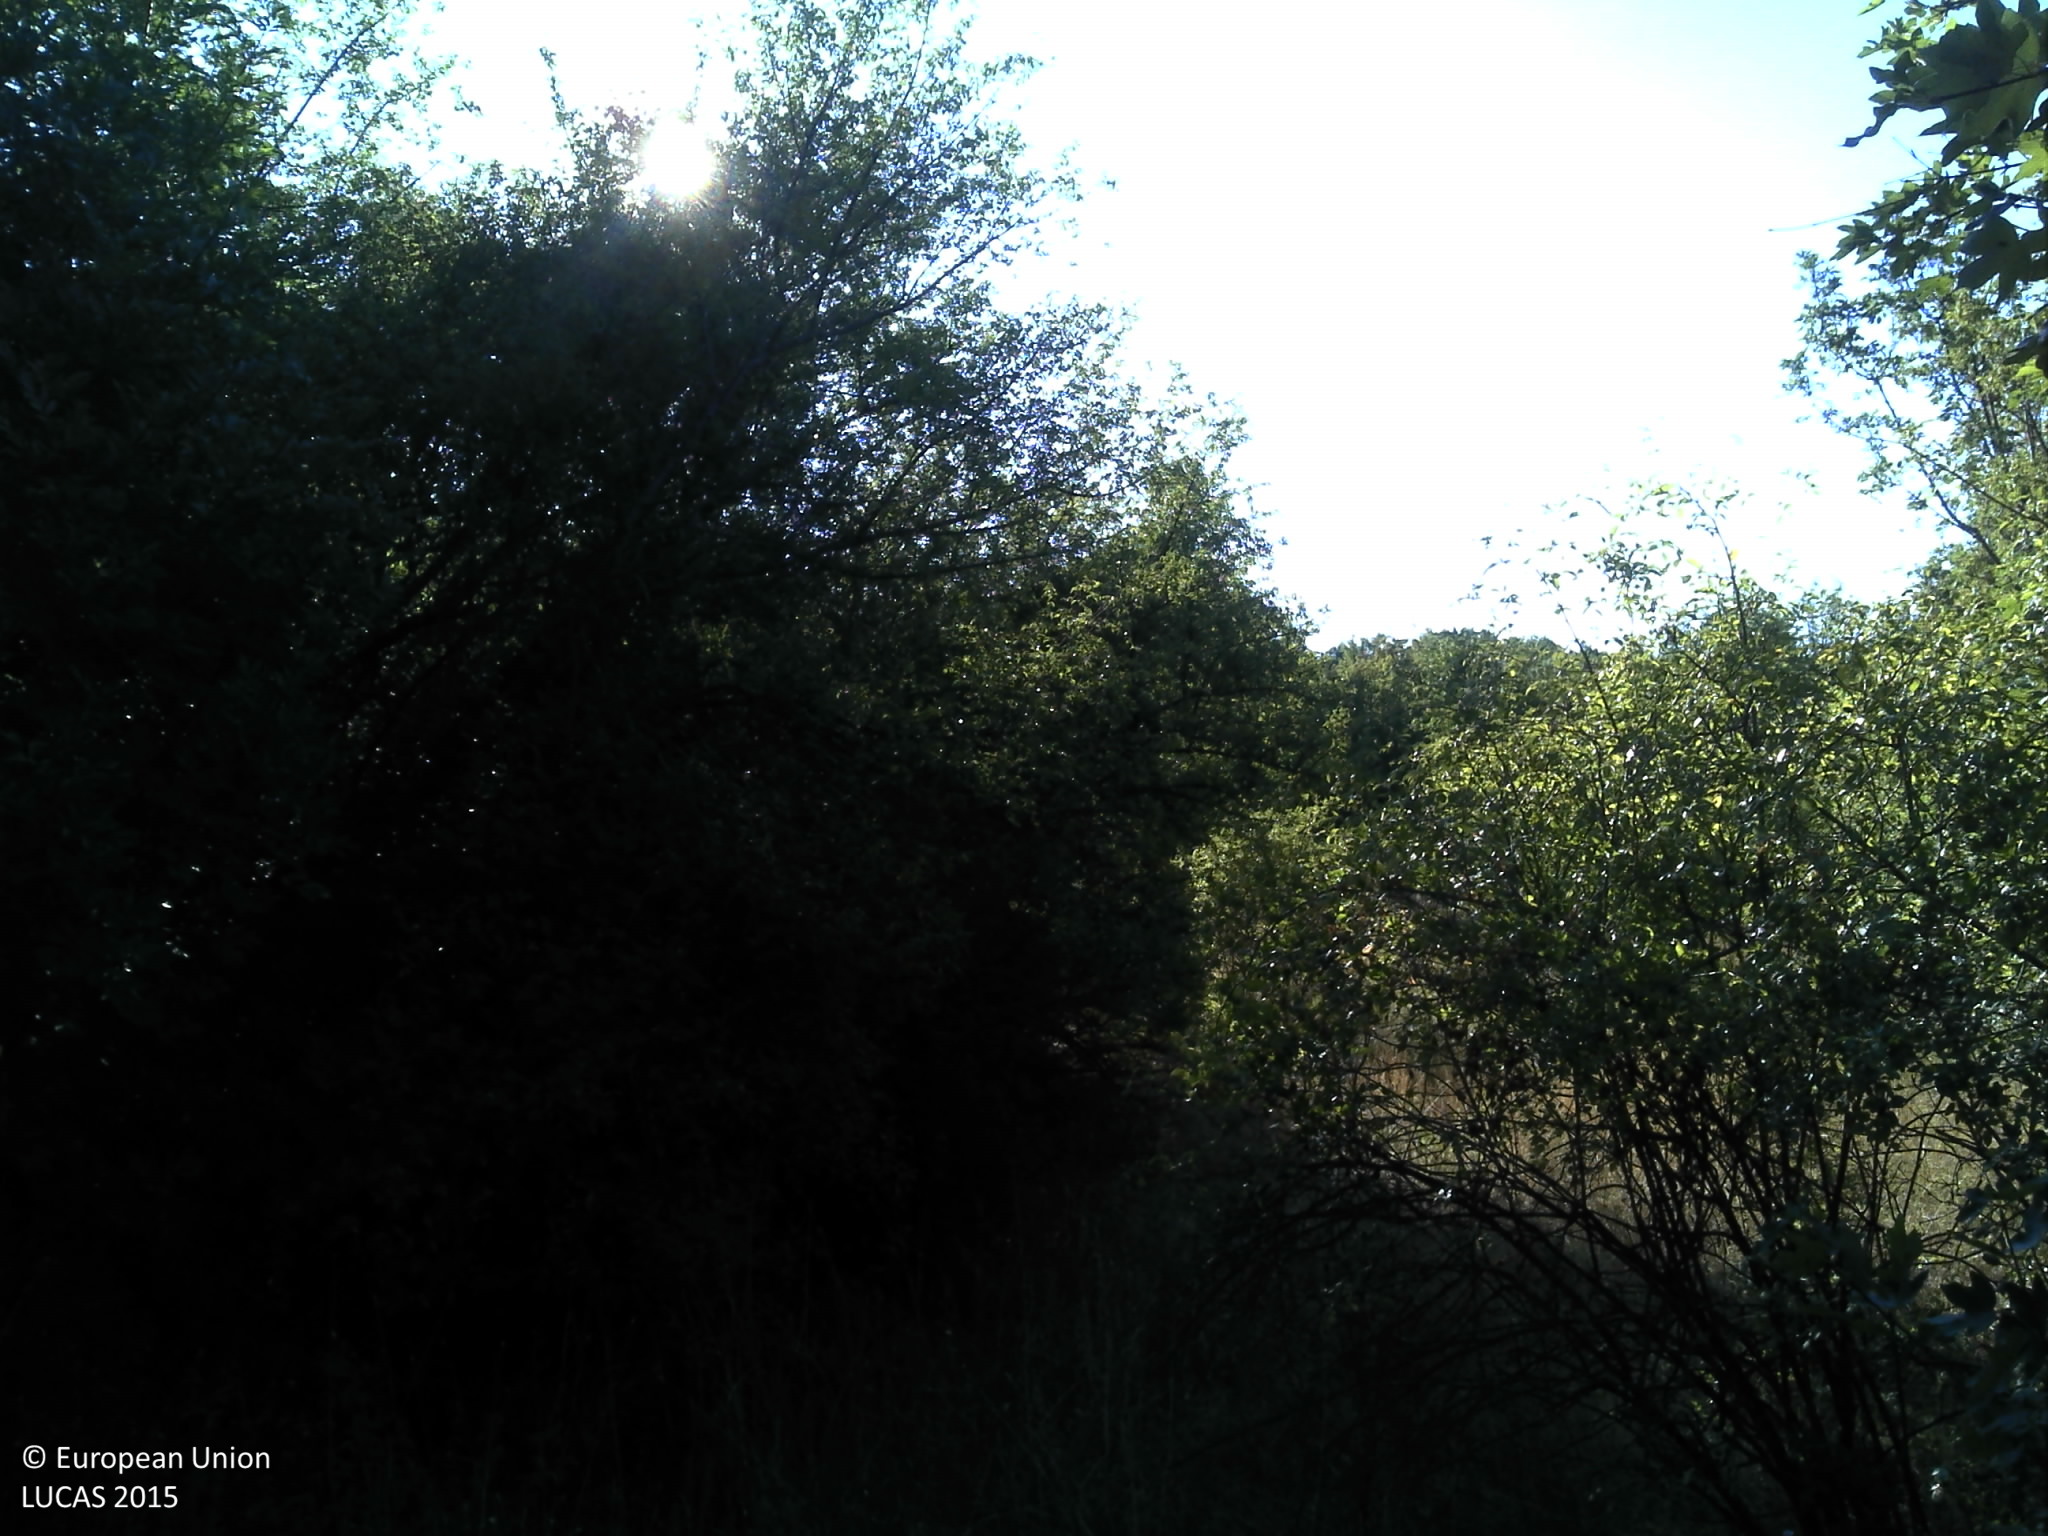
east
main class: Woodland
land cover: Broadleaved woodland
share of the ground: 25 - 50 %
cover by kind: broadleaved forest trees 40 %, shrubs 30 %, herbaceous plants 30 %
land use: Semi-natural and natural areas not in use
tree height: > 5 m
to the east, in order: Broadleaved woodland; Dry stone walls; Grassland with sparse tree/shrub cover; Shrubland with sparse tree cover; Dry stone walls; Grassland with sparse tree/shrub cover; Shrubland with sparse tree cover; Dry stone walls; Tracks; Dry stone walls; Shrubland with sparse tree cover; Grassland with sparse tree/shrub cover; Shrubland with sparse tree cover; Grassland with sparse tree/shrub cover; Dry stone walls; Shrubland with sparse tree cover; Dry stone walls; Grassland with sparse tree/shrub cover; Dry stone walls; Shrubland with sparse tree cover; Dry stone walls; Grassland with sparse tree/shrub cover; Dry stone walls; Electric lines; Shrubland with sparse tree cover
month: July
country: HR
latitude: 44.0807
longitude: 16.0991
